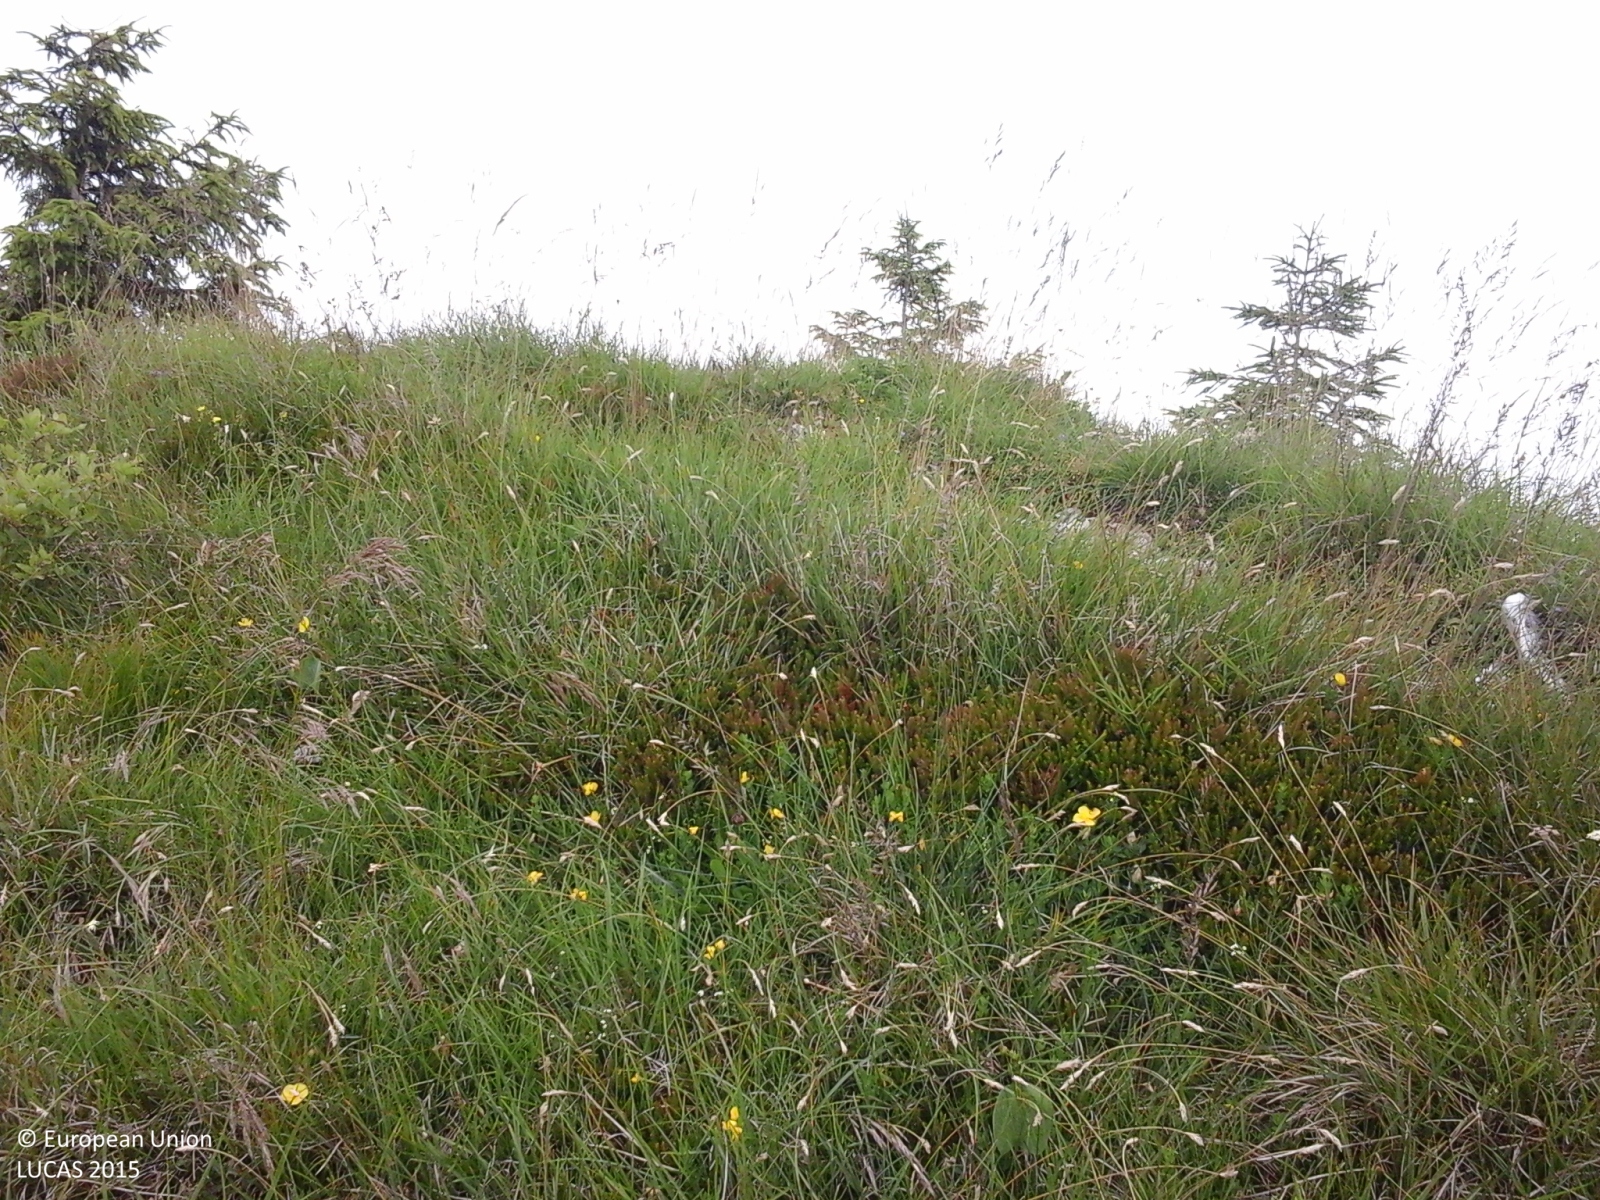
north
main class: Grassland
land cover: Grassland with sparse tree/shrub cover
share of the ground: > 75 %
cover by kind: herbaceous plants 90 %, coniferous forest trees 5 %, shrubs 5 %
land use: Agriculture (excluding fallow land and kitchen gardens)
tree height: < 5 m
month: June
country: IT
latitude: 45.8468
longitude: 9.9357
